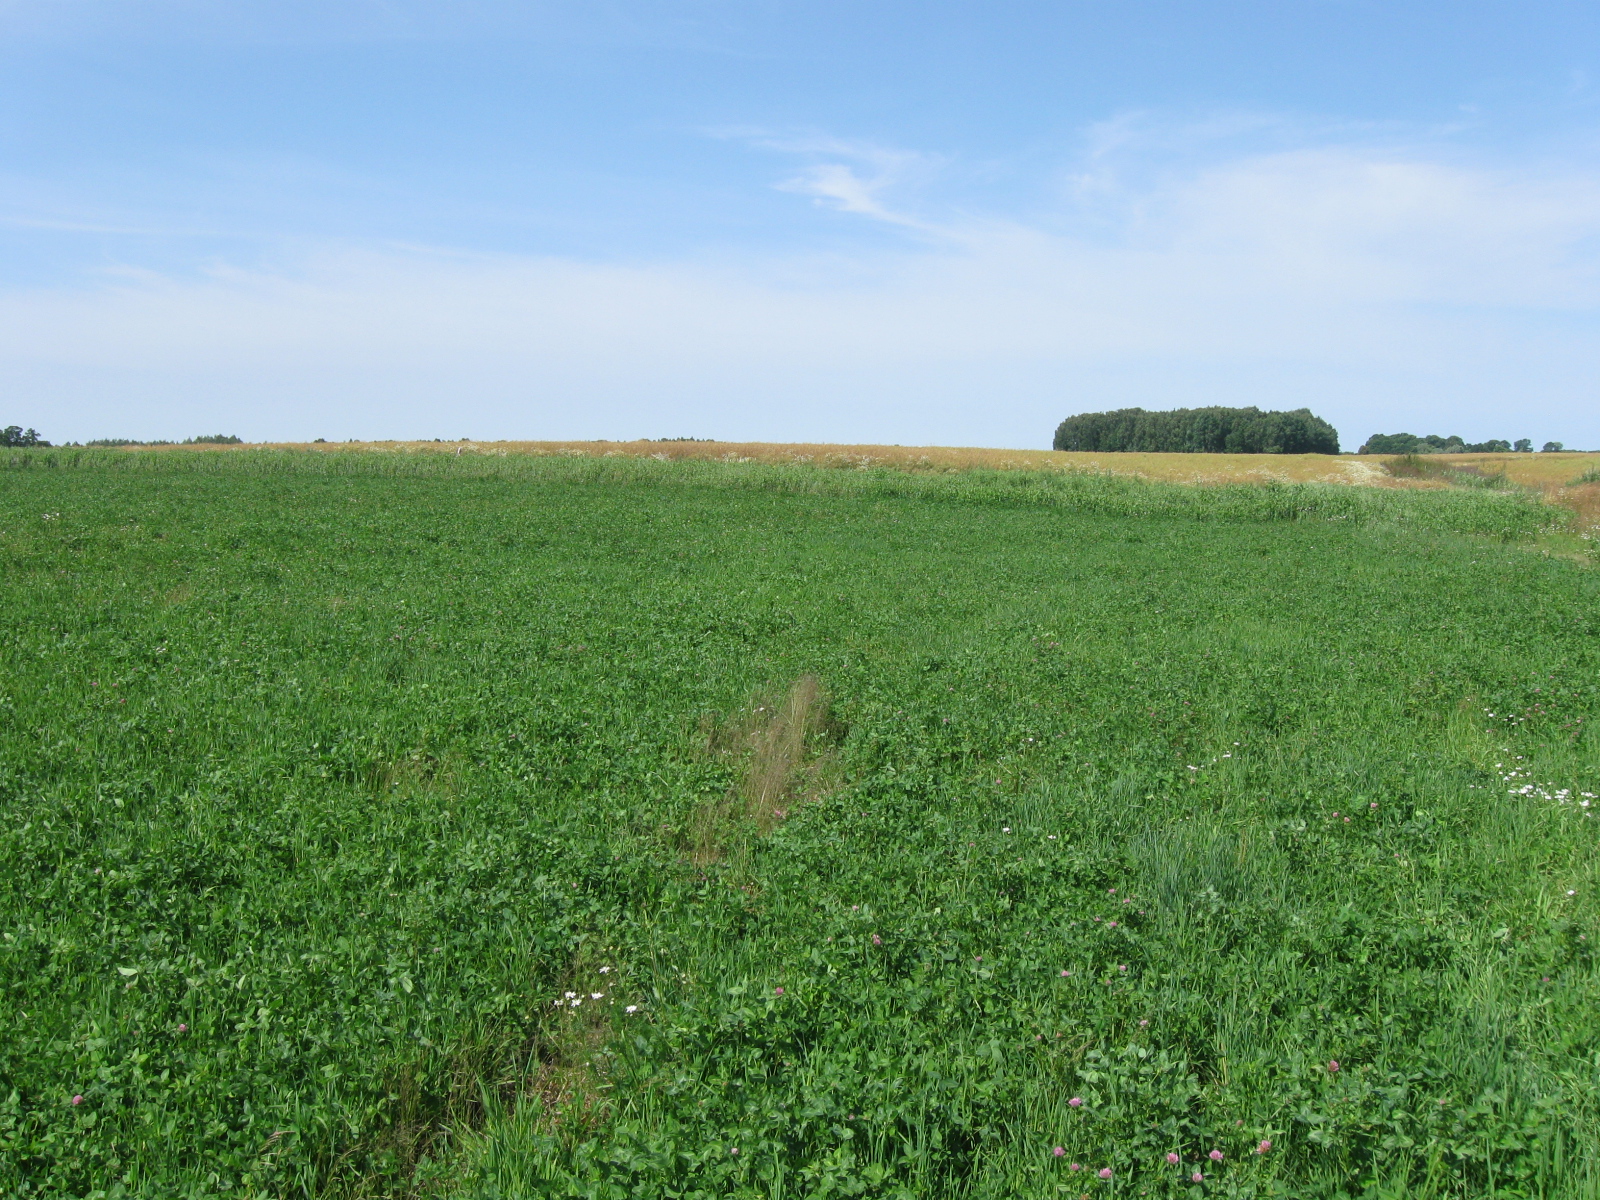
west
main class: Cropland
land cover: Clovers
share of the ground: > 75 %
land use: Agriculture (excluding fallow land and kitchen gardens)
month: July
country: LT
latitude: 54.7148
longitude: 23.8891
